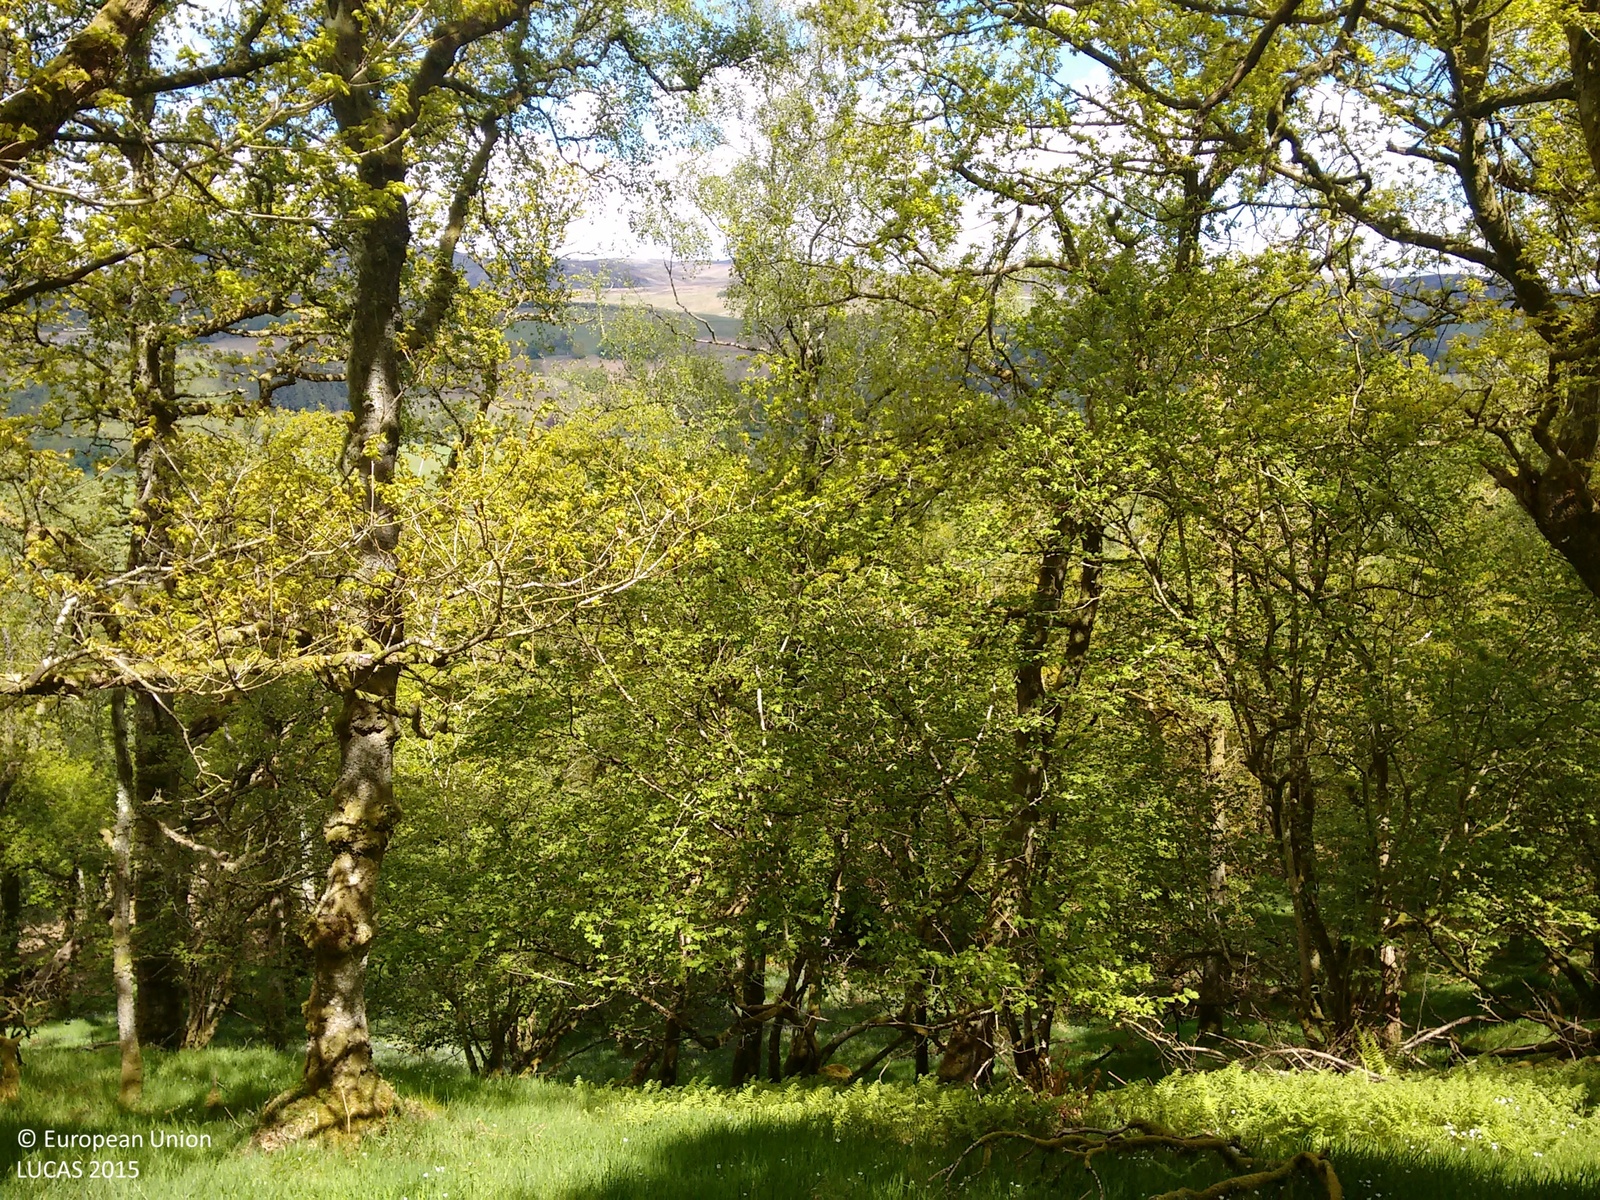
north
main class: Woodland
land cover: Broadleaved woodland
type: mesophytic deciduous forest
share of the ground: > 75 %
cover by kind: broadleaved forest trees 90 %, herbaceous plants 10 %
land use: Amenities, museums, leisure
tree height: > 5 m
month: May
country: GB
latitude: 56.3771
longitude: -3.8961
